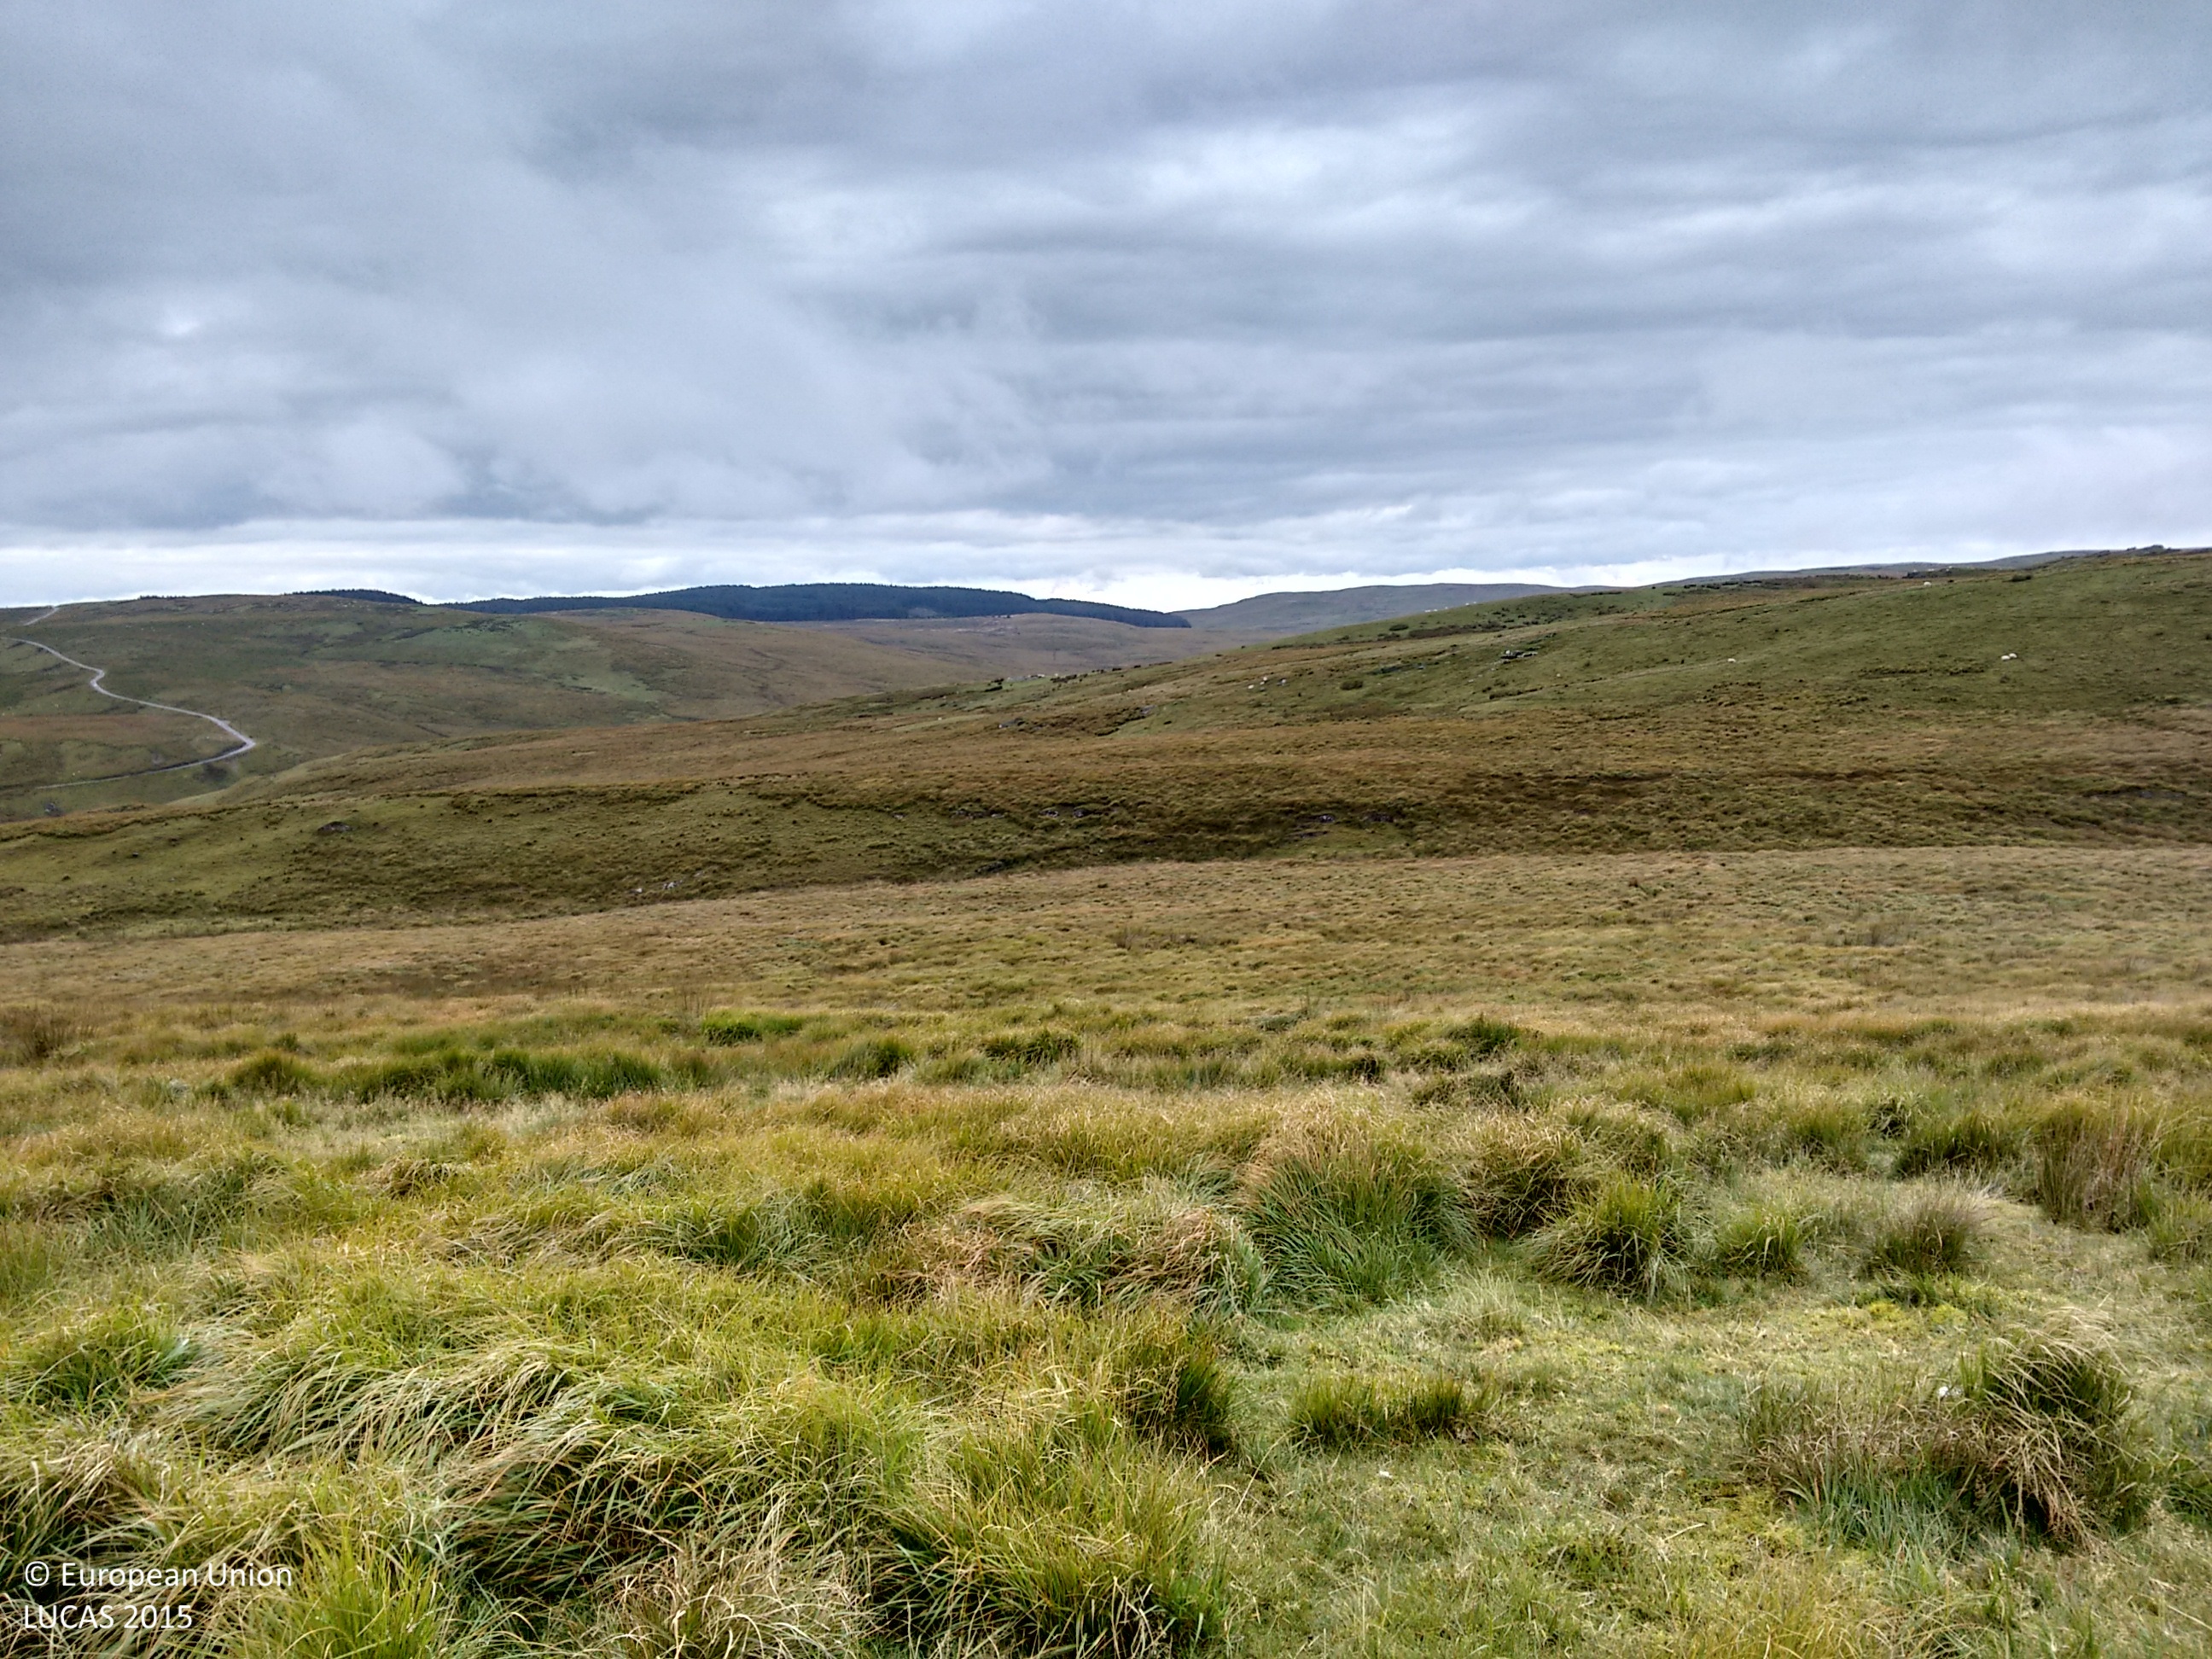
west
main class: Grassland
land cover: Grassland without tree/shrub cover
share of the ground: > 75 %
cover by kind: herbaceous plants 100 %
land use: Agriculture (excluding fallow land and kitchen gardens)
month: September
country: GB
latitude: 52.2049
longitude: -3.8015
